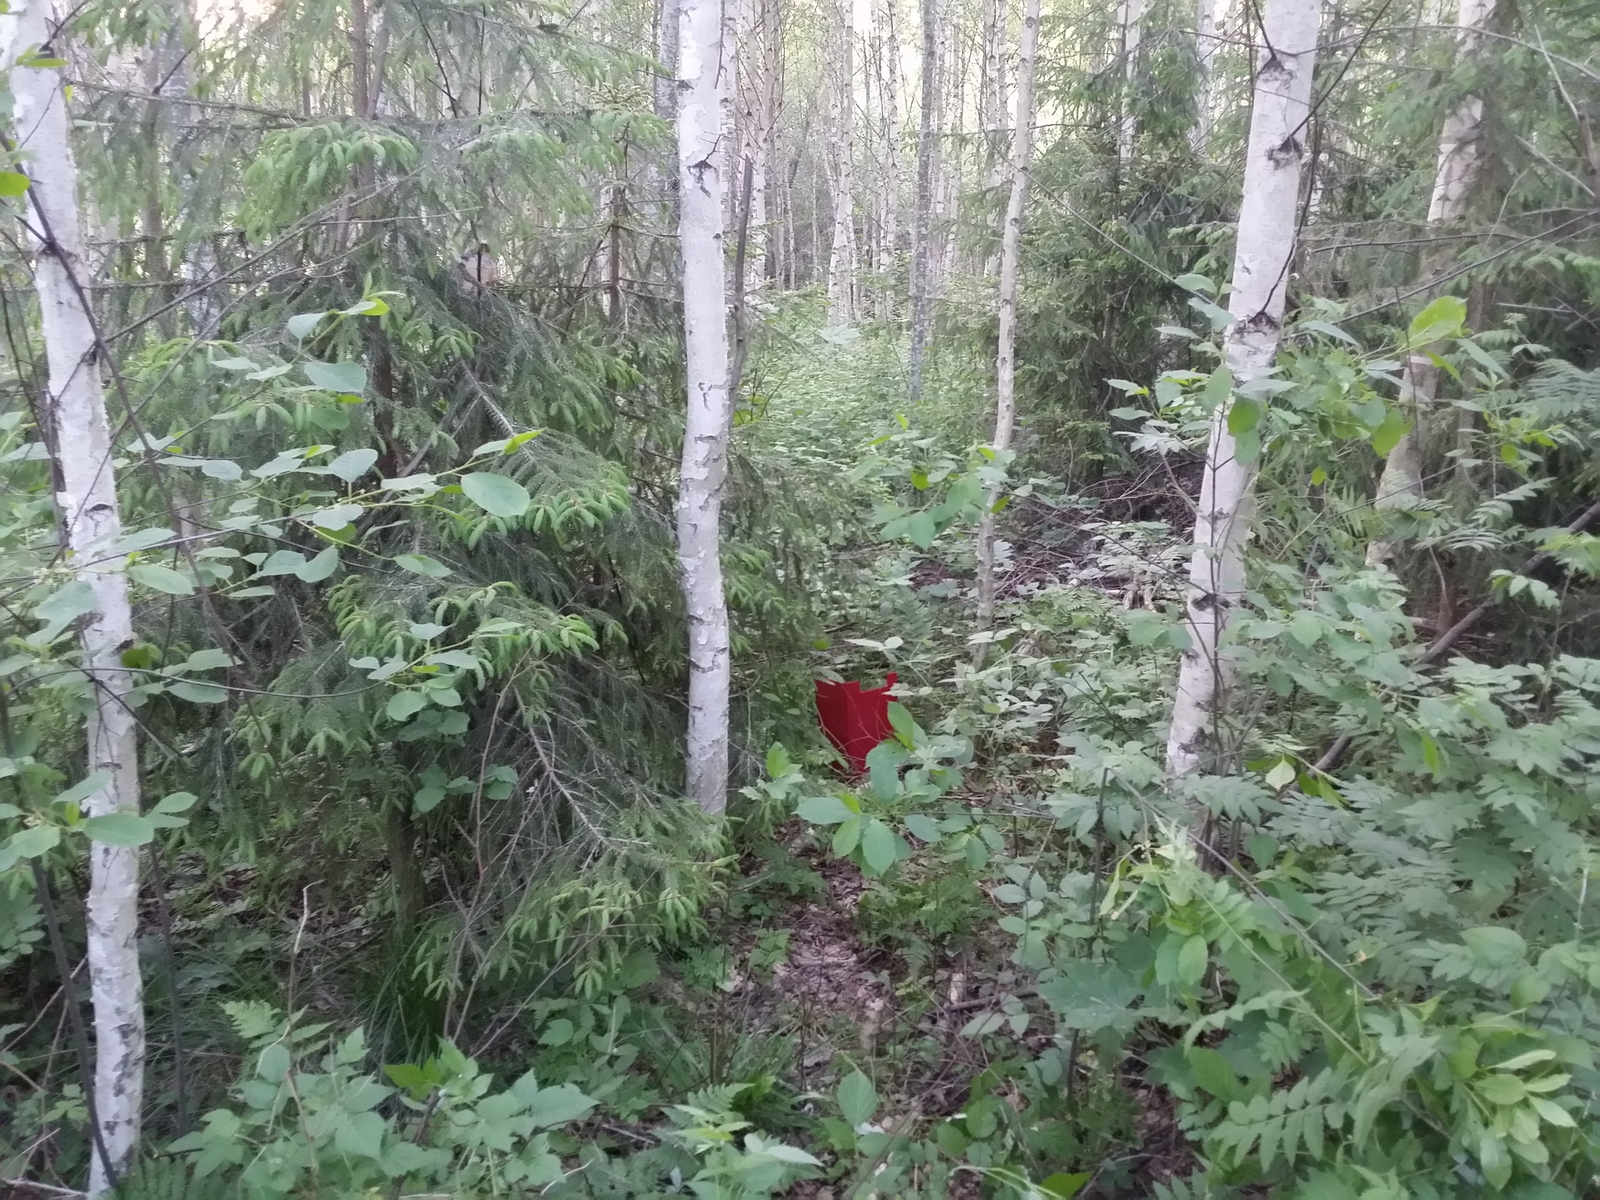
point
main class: Woodland
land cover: Spruce dominated mixed woodland
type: hemiboreal forest and nemoral coniferous forest and mixed broadleaved-coniferous forest
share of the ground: > 75 %
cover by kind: broadleaved forest trees 60 %, coniferous forest trees 20 %, shrubs 10 %, herbaceous plants 10 %
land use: Forestry
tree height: > 5 m
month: June
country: LV
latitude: 57.3052
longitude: 26.5960
